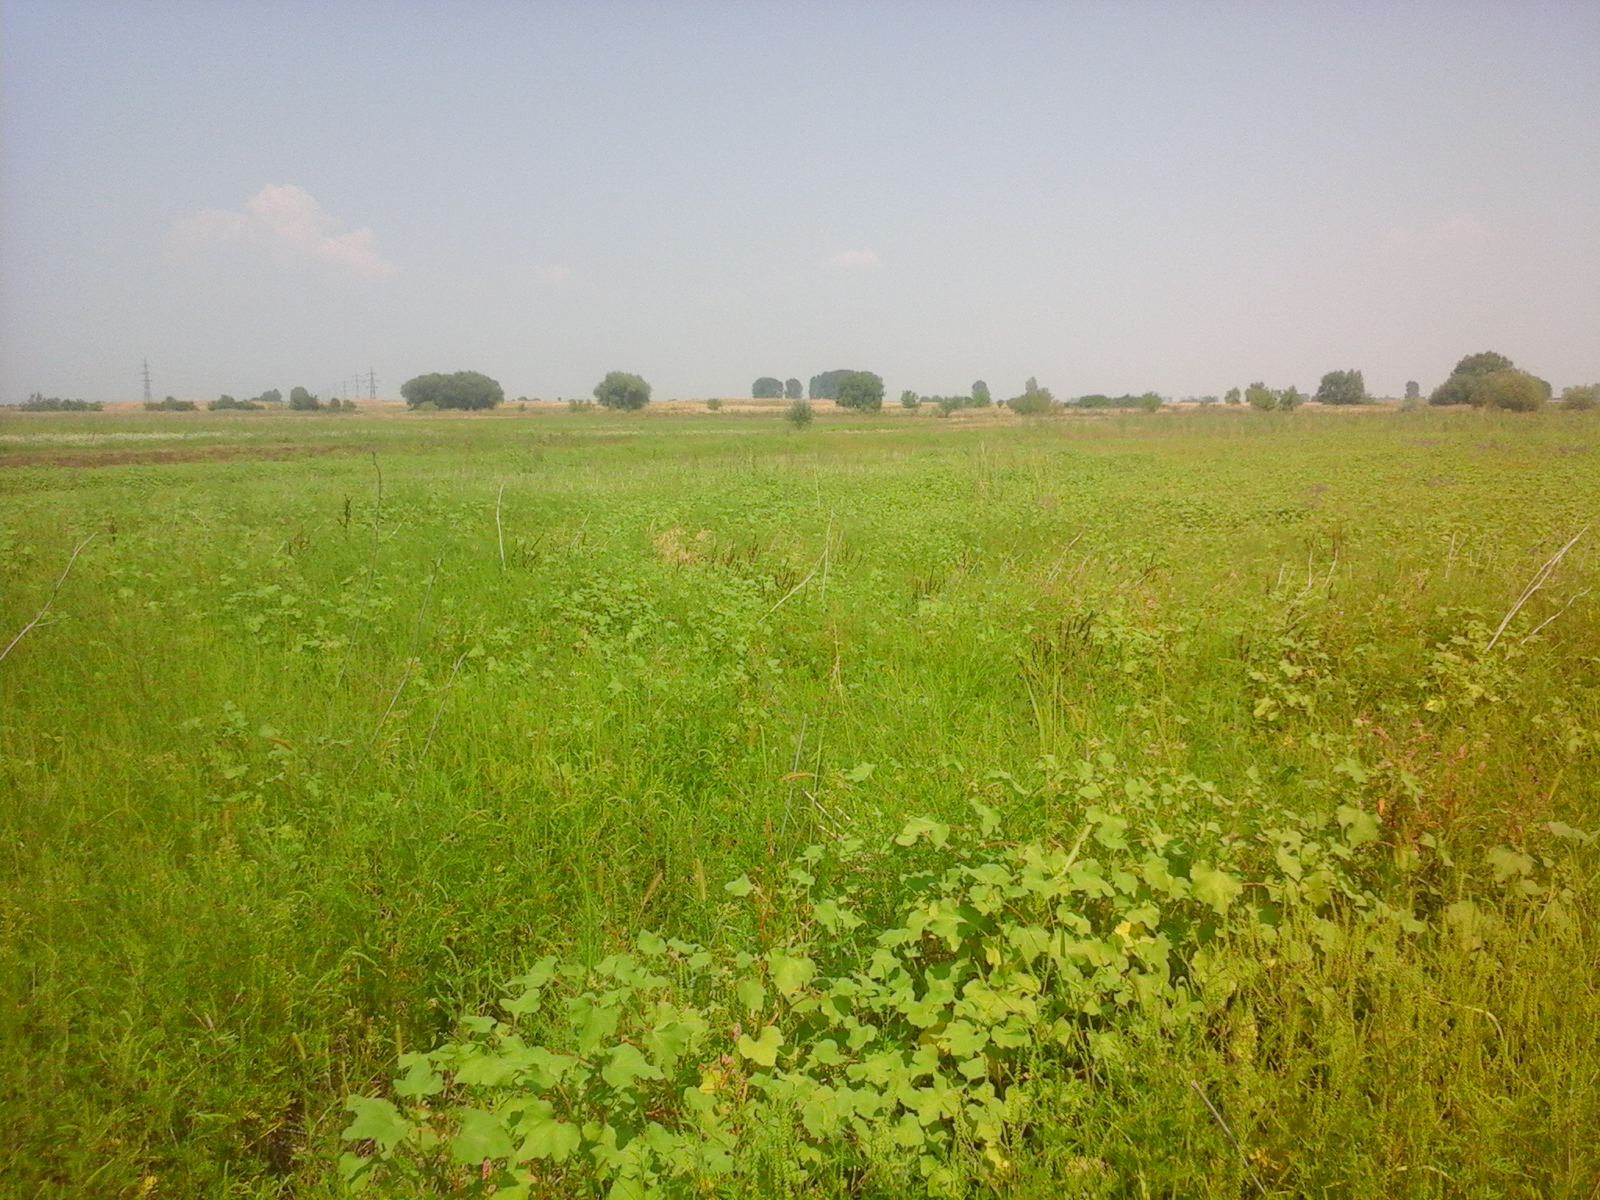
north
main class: Grassland
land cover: Spontaneously vegetated surfaces
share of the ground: > 75 %
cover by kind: herbaceous plants 100 %
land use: Fallow land
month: August
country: RO
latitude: 44.3811
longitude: 22.6029
